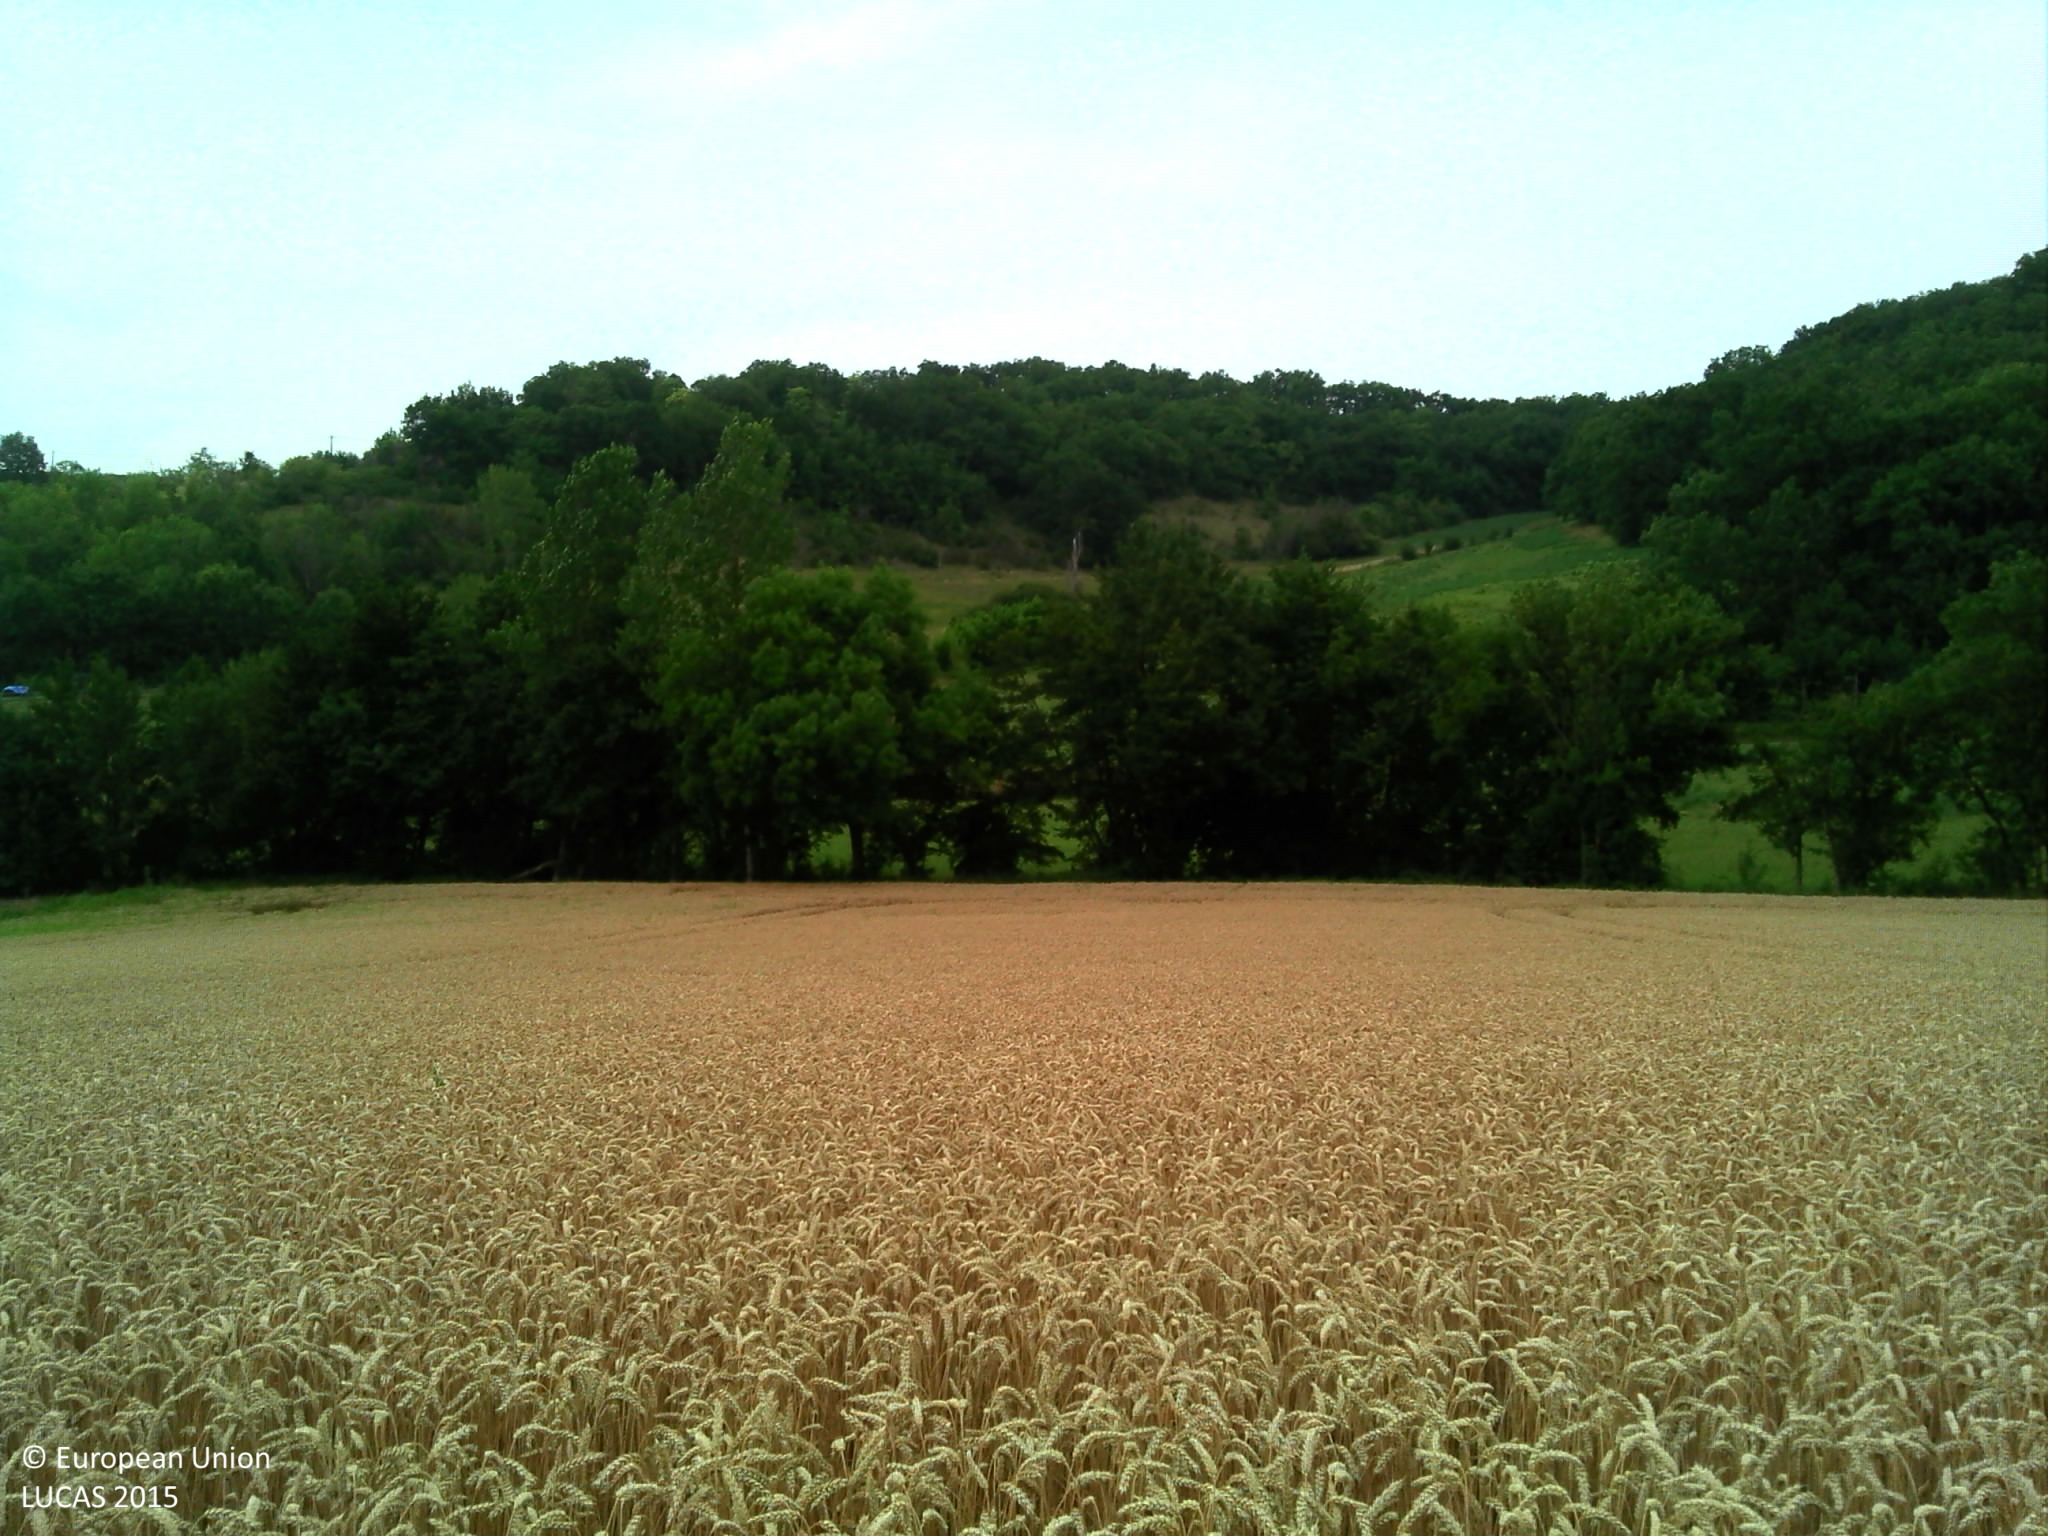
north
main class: Cropland
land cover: Common wheat
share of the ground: > 75 %
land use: Agriculture (excluding fallow land and kitchen gardens)
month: July
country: FR
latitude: 44.3426
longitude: 0.8261
